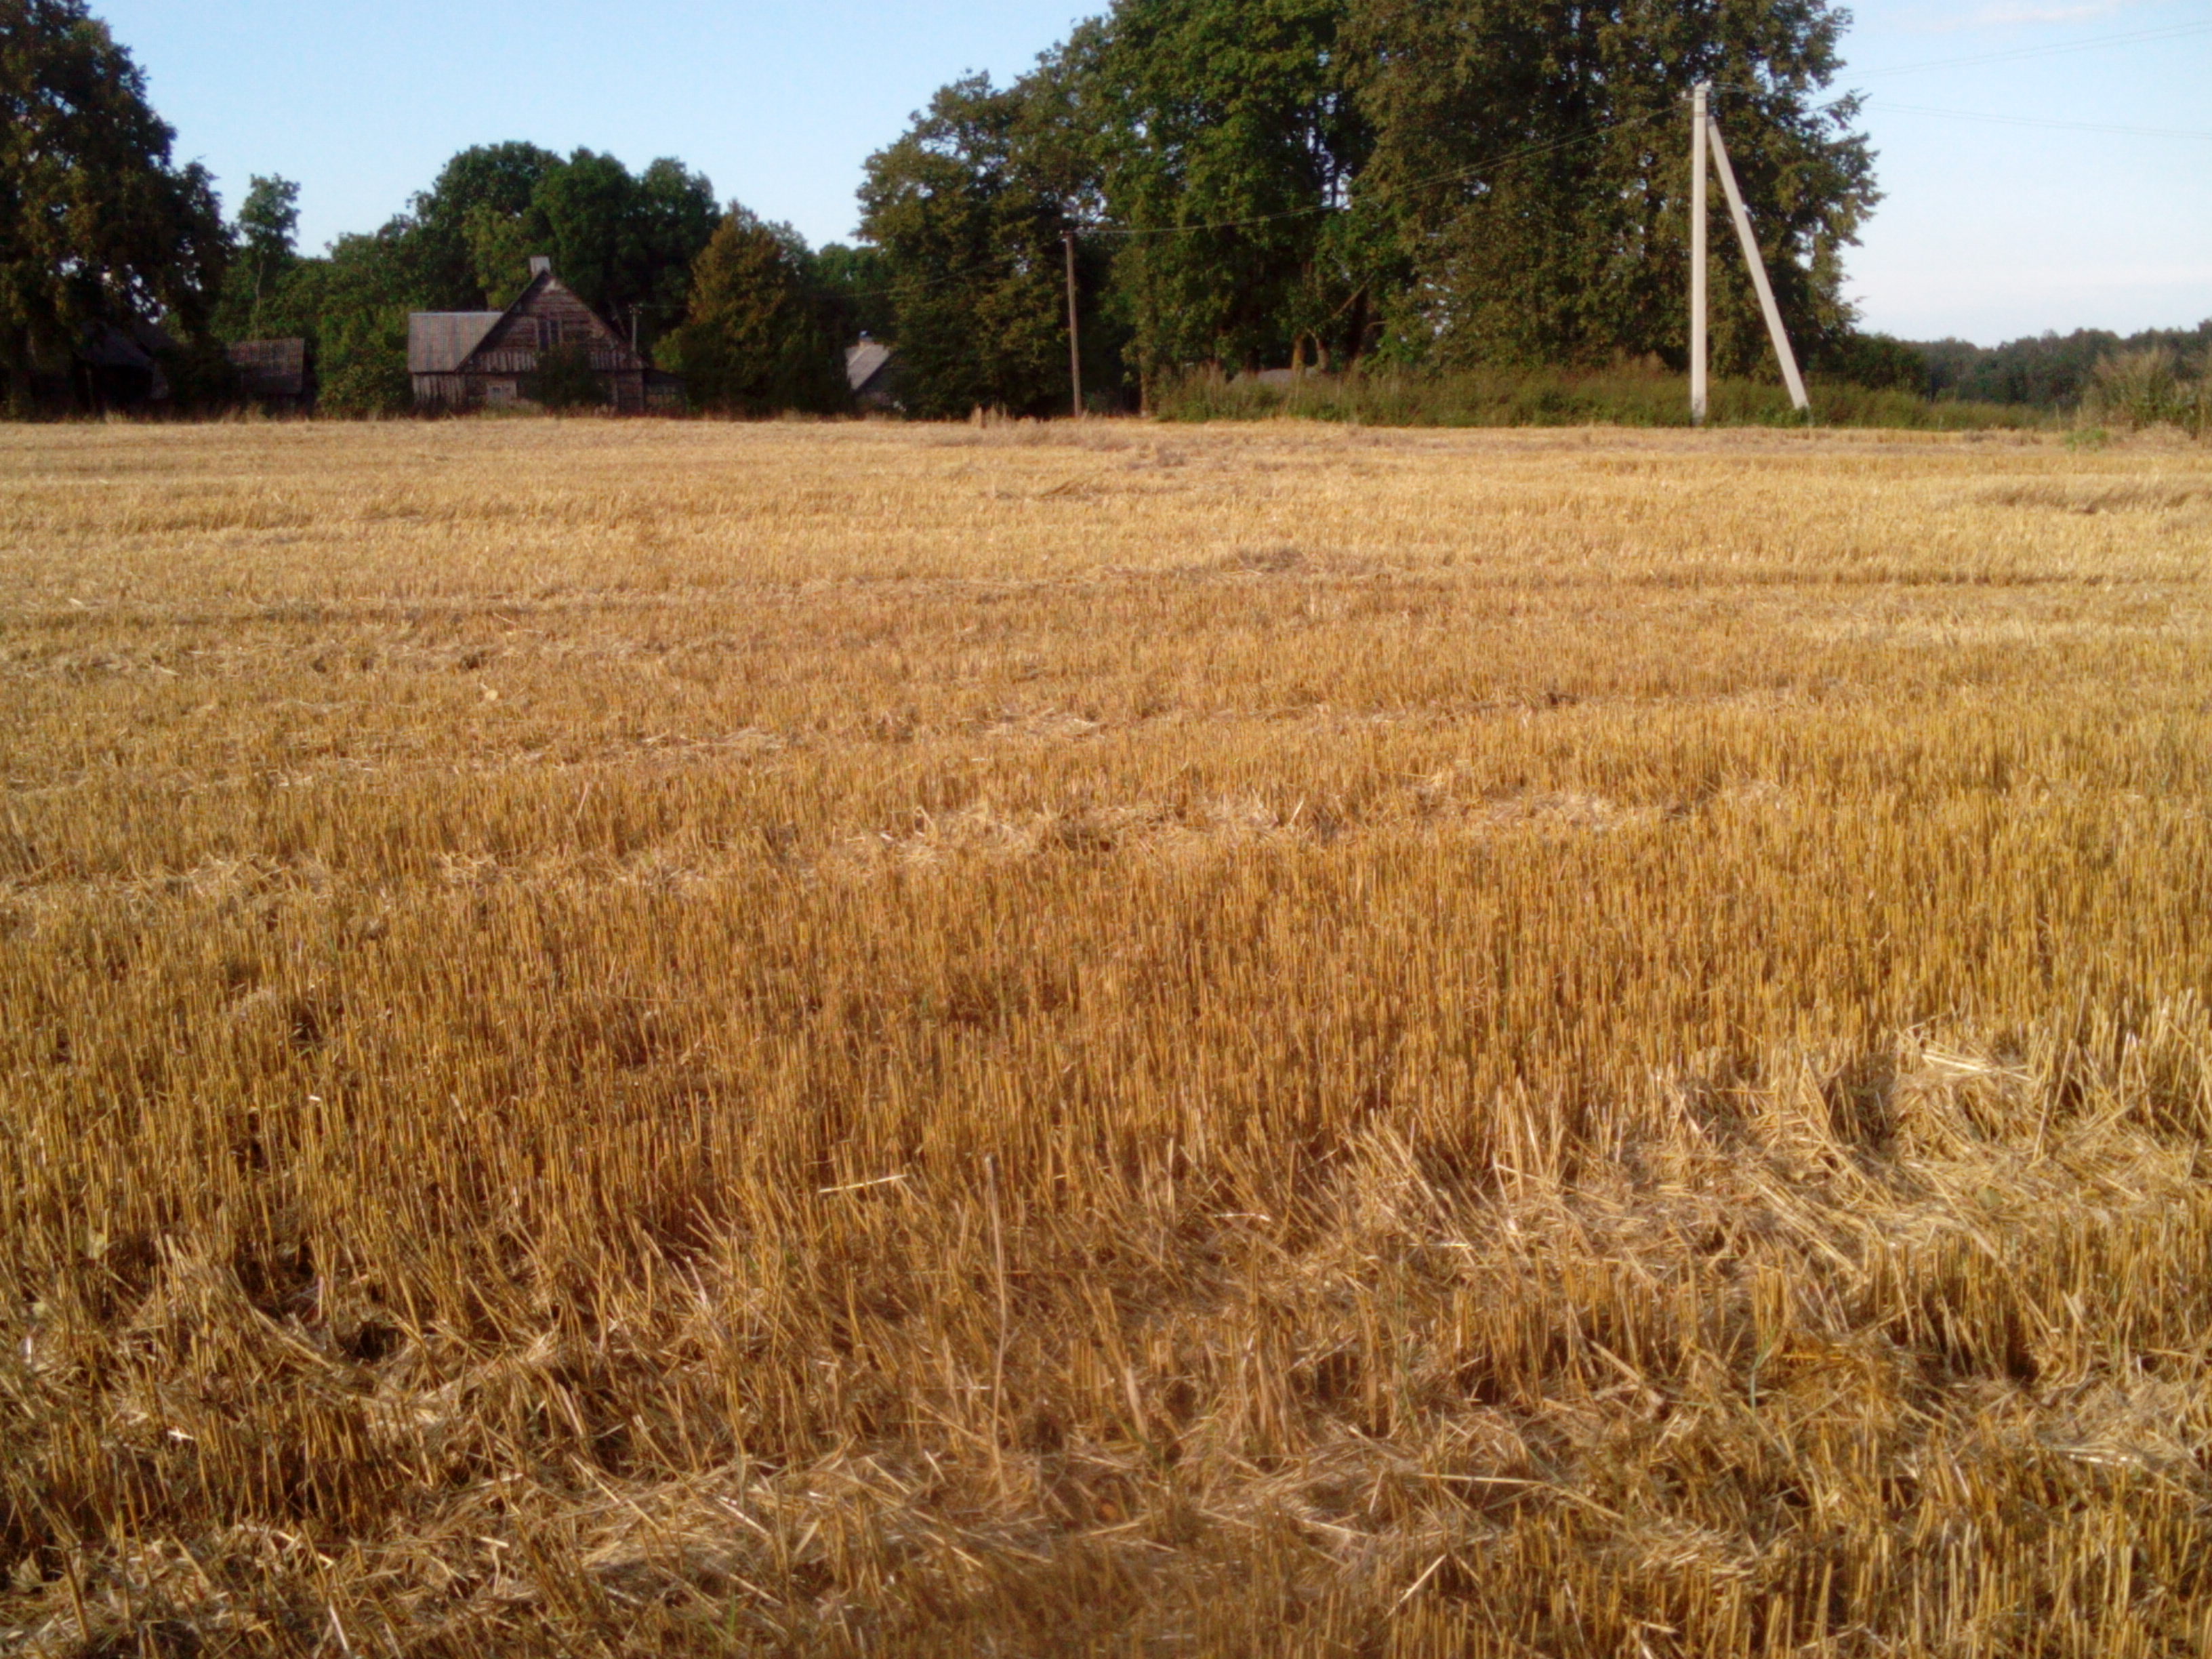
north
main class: Cropland
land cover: Common wheat
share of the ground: > 75 %
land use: Agriculture (excluding fallow land and kitchen gardens)
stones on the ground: < 10 %
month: September
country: LT
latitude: 55.9001
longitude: 22.8768
